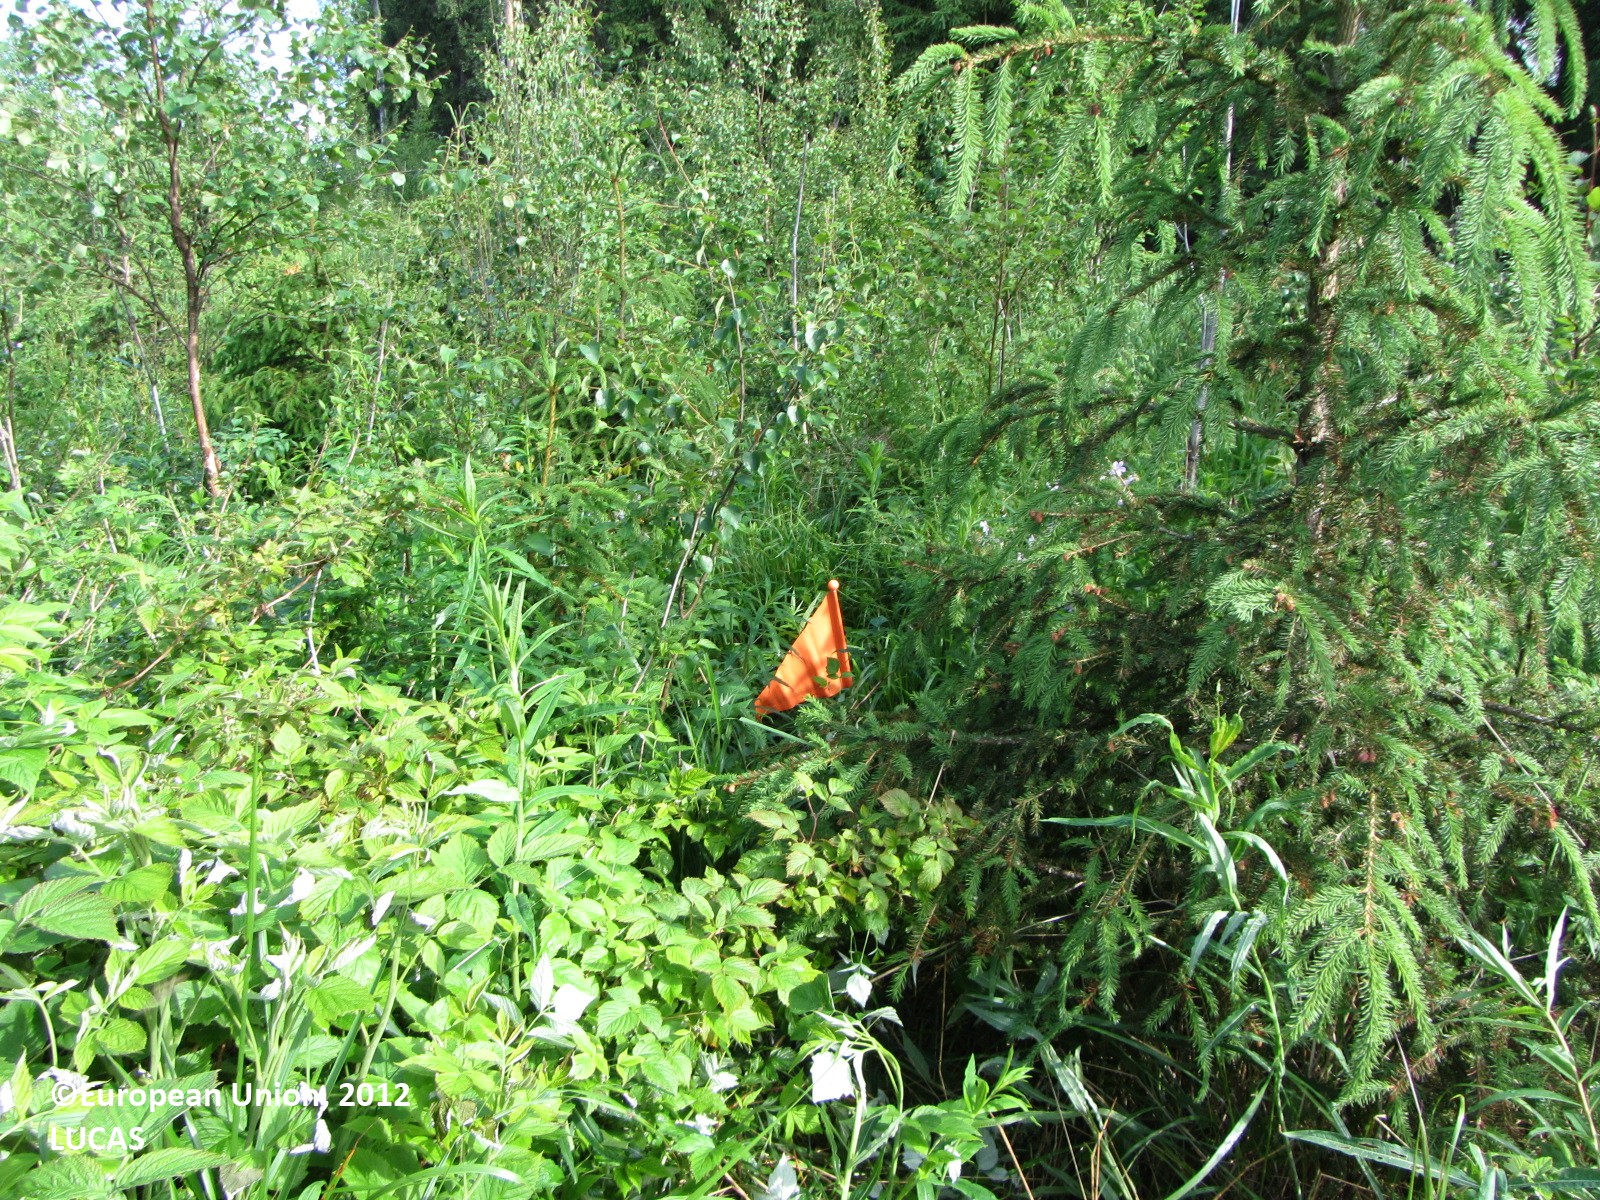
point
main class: Woodland
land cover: Broadleaved woodland
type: boreal forest
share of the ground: > 75 %
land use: Forestry
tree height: > 5 m
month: July
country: FI
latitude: 62.9560
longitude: 25.5847
